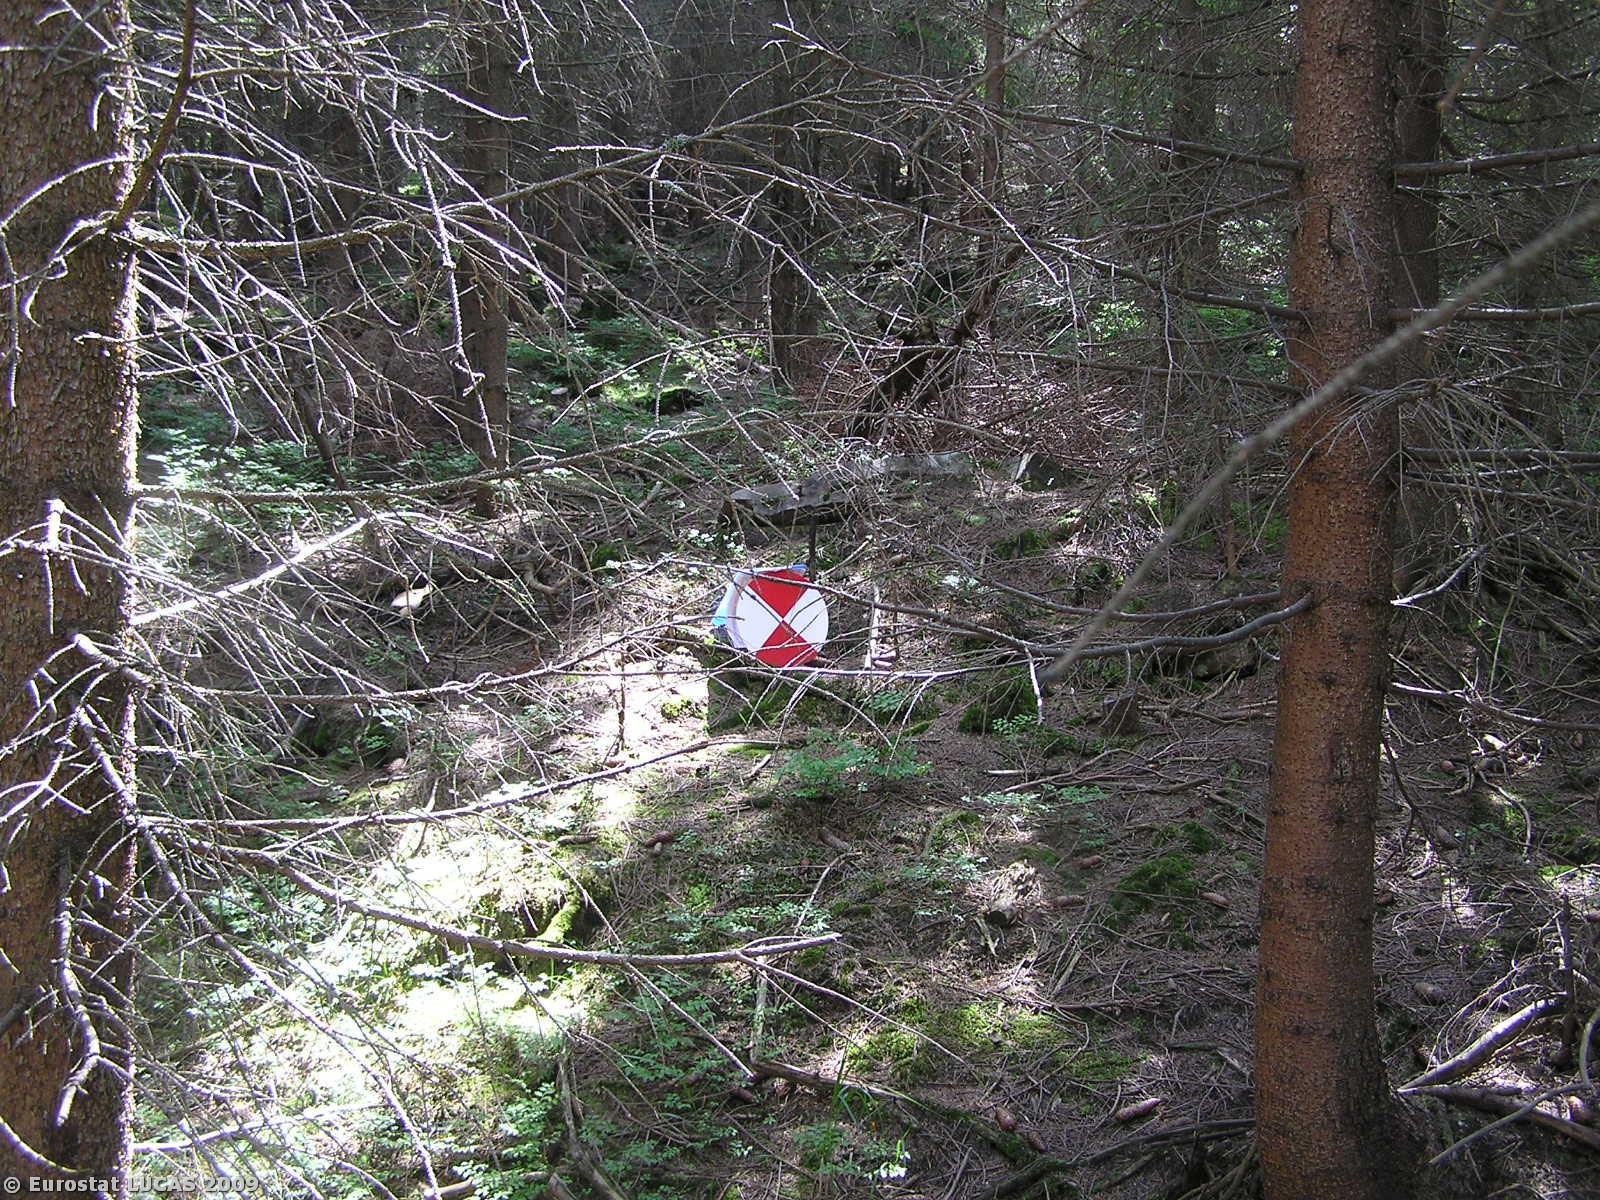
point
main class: Woodland
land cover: Coniferous woodland
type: hemiboreal forest and nemoral coniferous forest and mixed broadleaved-coniferous forest
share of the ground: > 75 %
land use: Forestry
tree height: > 5 m
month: July
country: CZ
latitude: 50.2040
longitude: 17.2829
